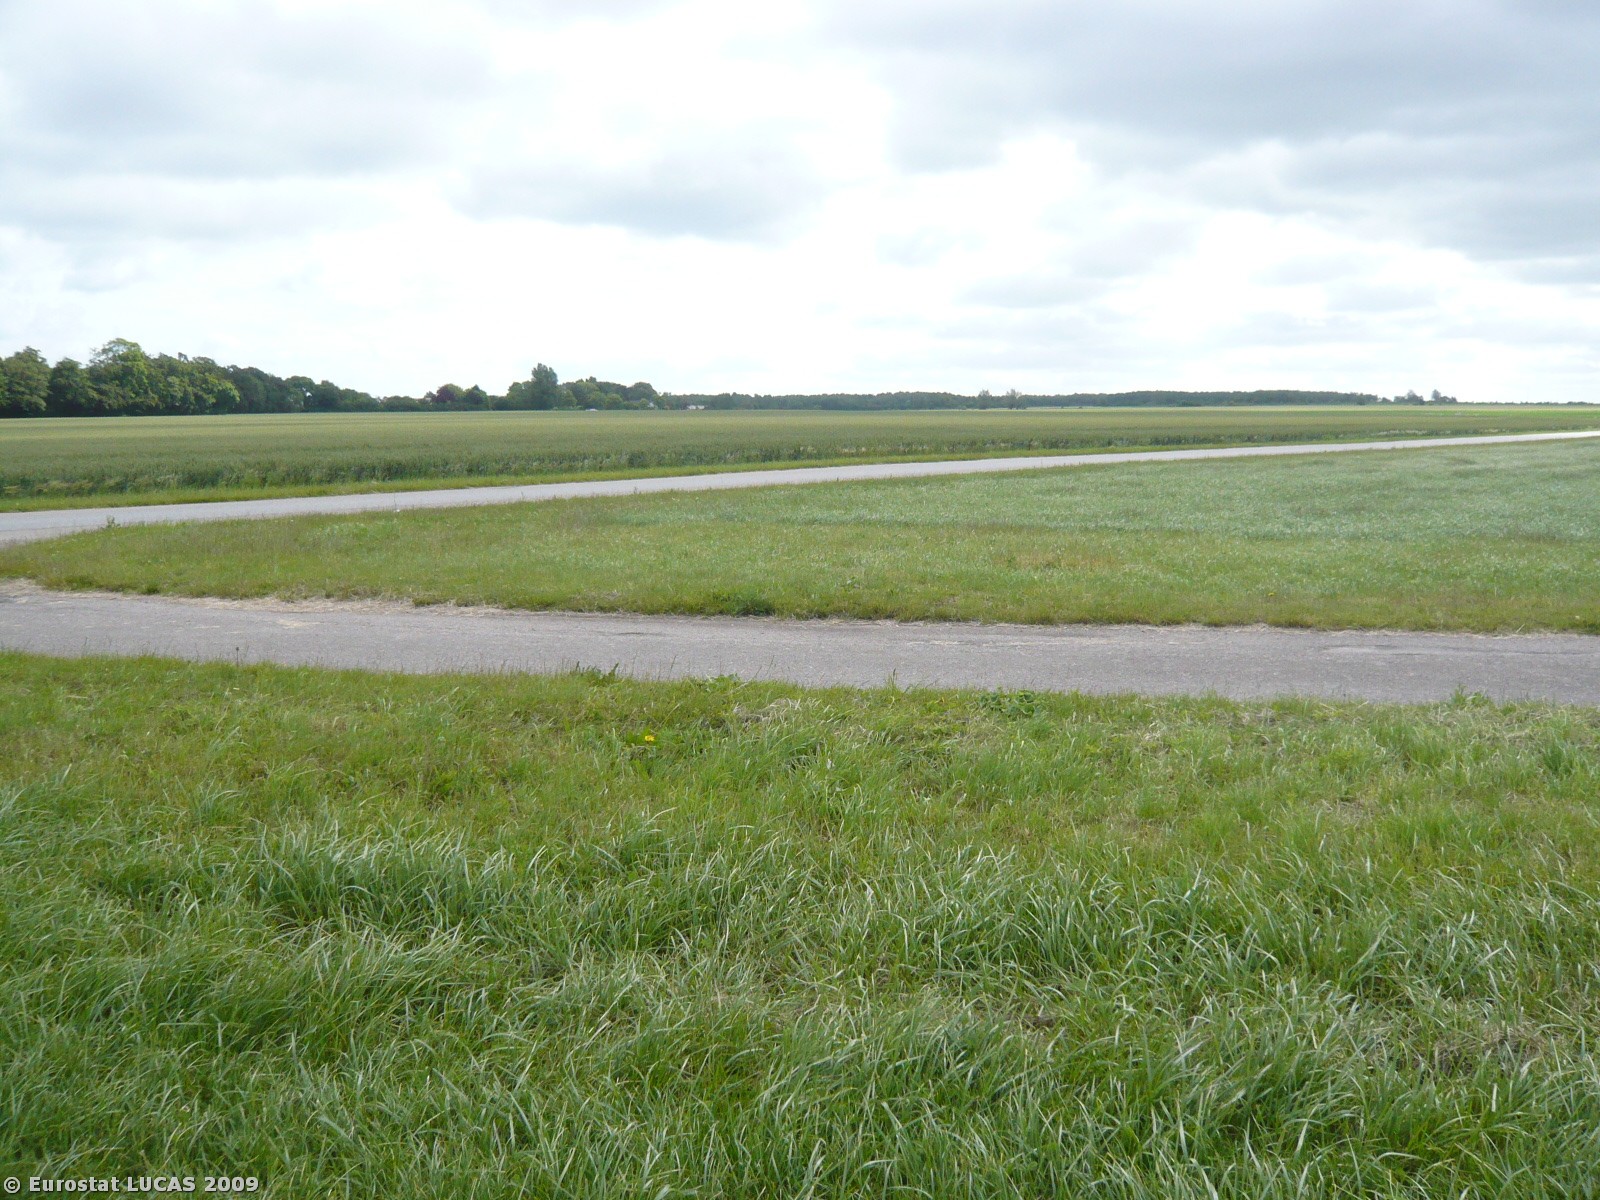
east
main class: Cropland
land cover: Common wheat
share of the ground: > 75 %
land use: Agriculture (excluding fallow land and kitchen gardens)
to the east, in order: Common wheat; Temporary grasslands
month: June
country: DK
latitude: 54.9238
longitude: 11.2006
